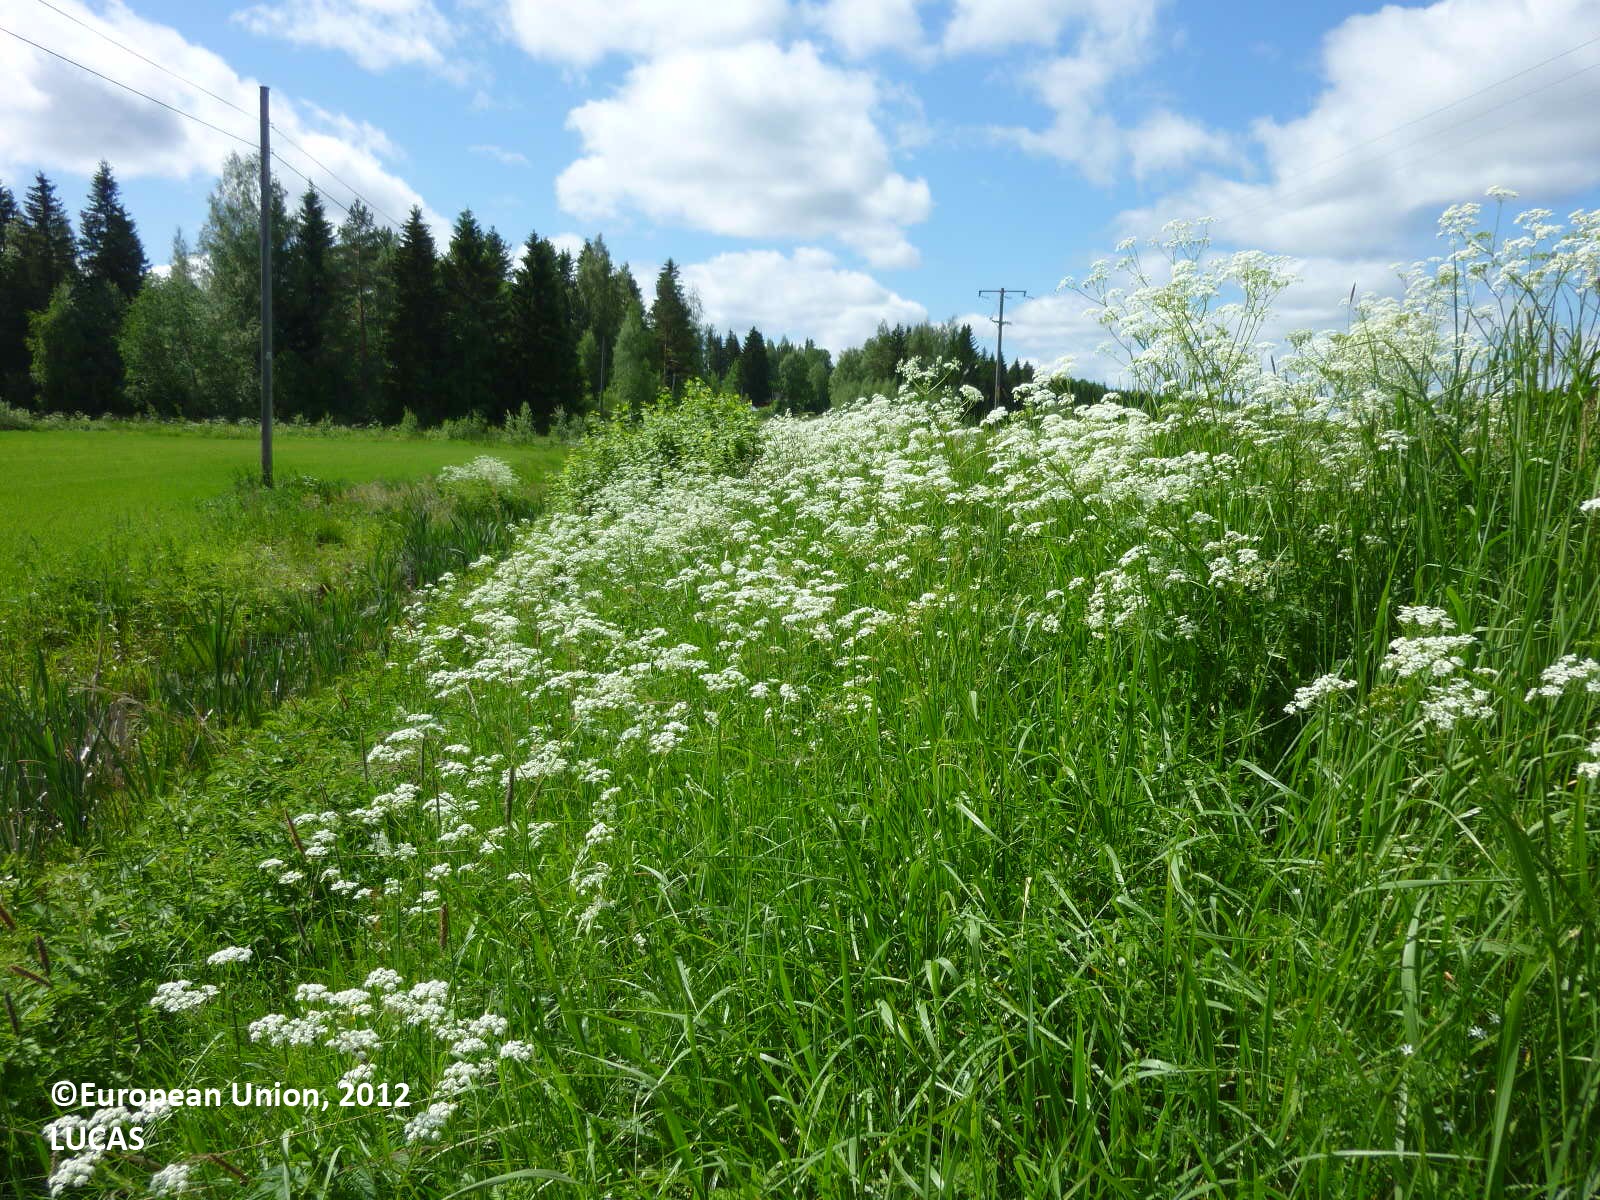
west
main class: Cropland
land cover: Barley
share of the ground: > 75 %
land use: Agriculture (excluding fallow land and kitchen gardens)
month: June
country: FI
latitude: 61.7250
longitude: 22.2641
